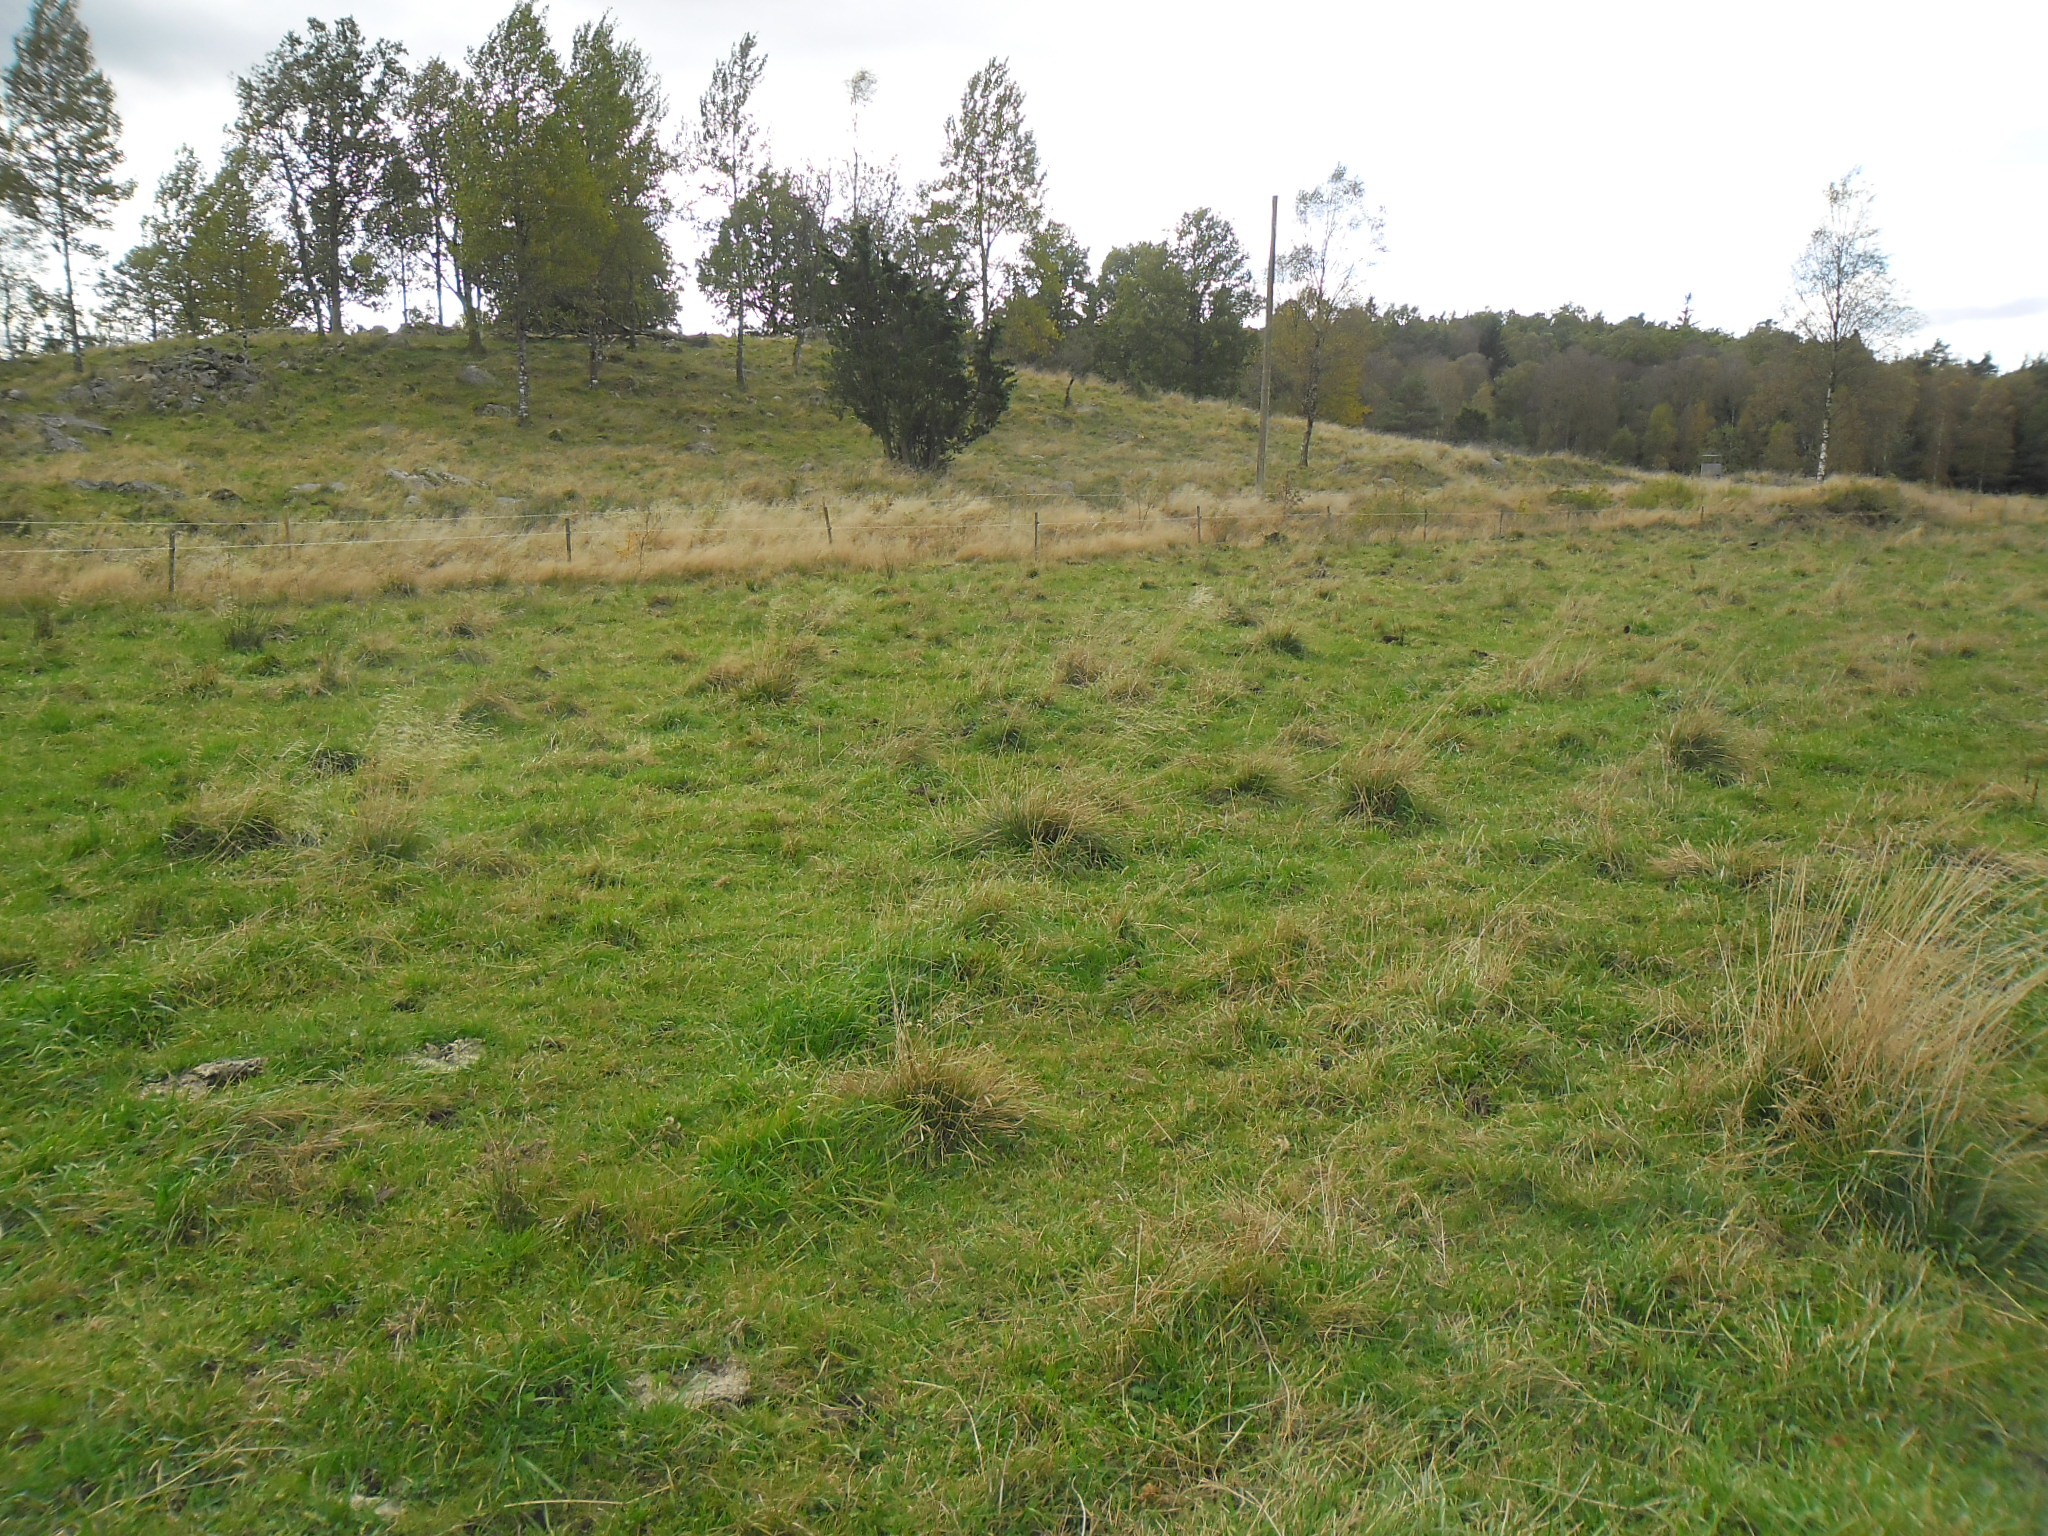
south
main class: Grassland
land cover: Grassland without tree/shrub cover
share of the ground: > 75 %
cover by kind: herbaceous plants 100 %
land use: Agriculture (excluding fallow land and kitchen gardens)
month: October
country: SE
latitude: 56.7061
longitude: 13.1819
